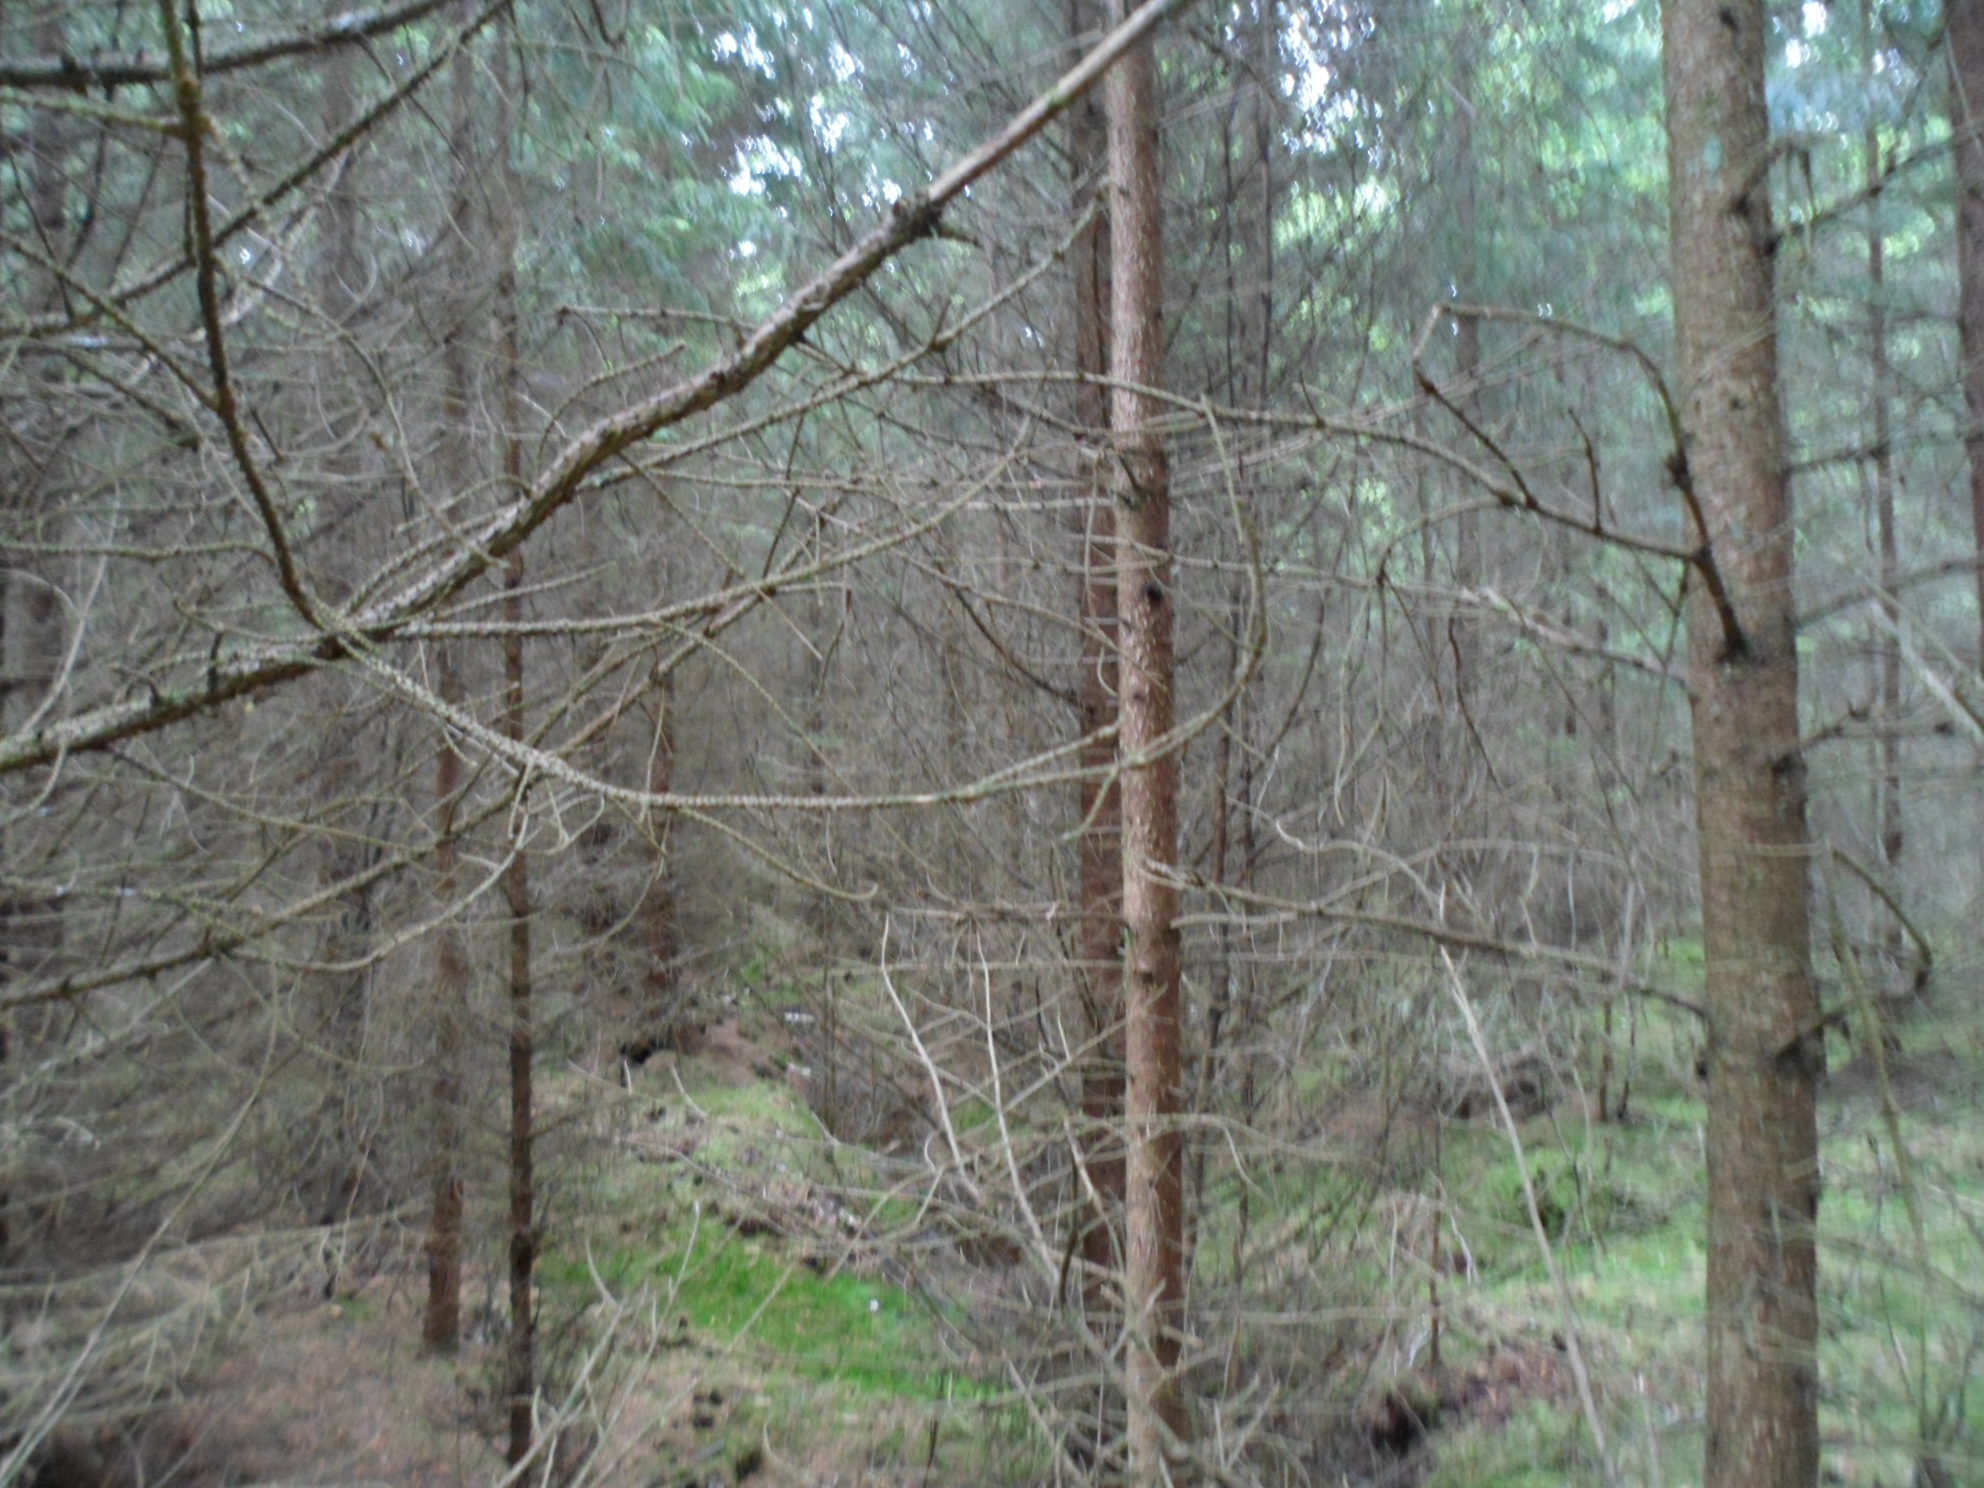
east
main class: Woodland
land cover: Spruce dominated coniferous woodland
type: boreal forest
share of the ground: > 75 %
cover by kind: coniferous forest trees 75 %, lichens and mosses 10 %, broadleaved forest trees 5 %, shrubs 5 %, herbaceous plants 5 %
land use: Forestry
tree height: > 5 m
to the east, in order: Spruce dominated coniferous woodland; Ditches and canals; Spruce dominated coniferous woodland; Ditches and canals; Spruce dominated coniferous woodland; Ditches and canals; Spruce dominated mixed woodland; Spruce dominated coniferous woodland; Tracks; Spruce dominated coniferous woodland
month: June
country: SE
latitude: 57.1302
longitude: 14.1098
